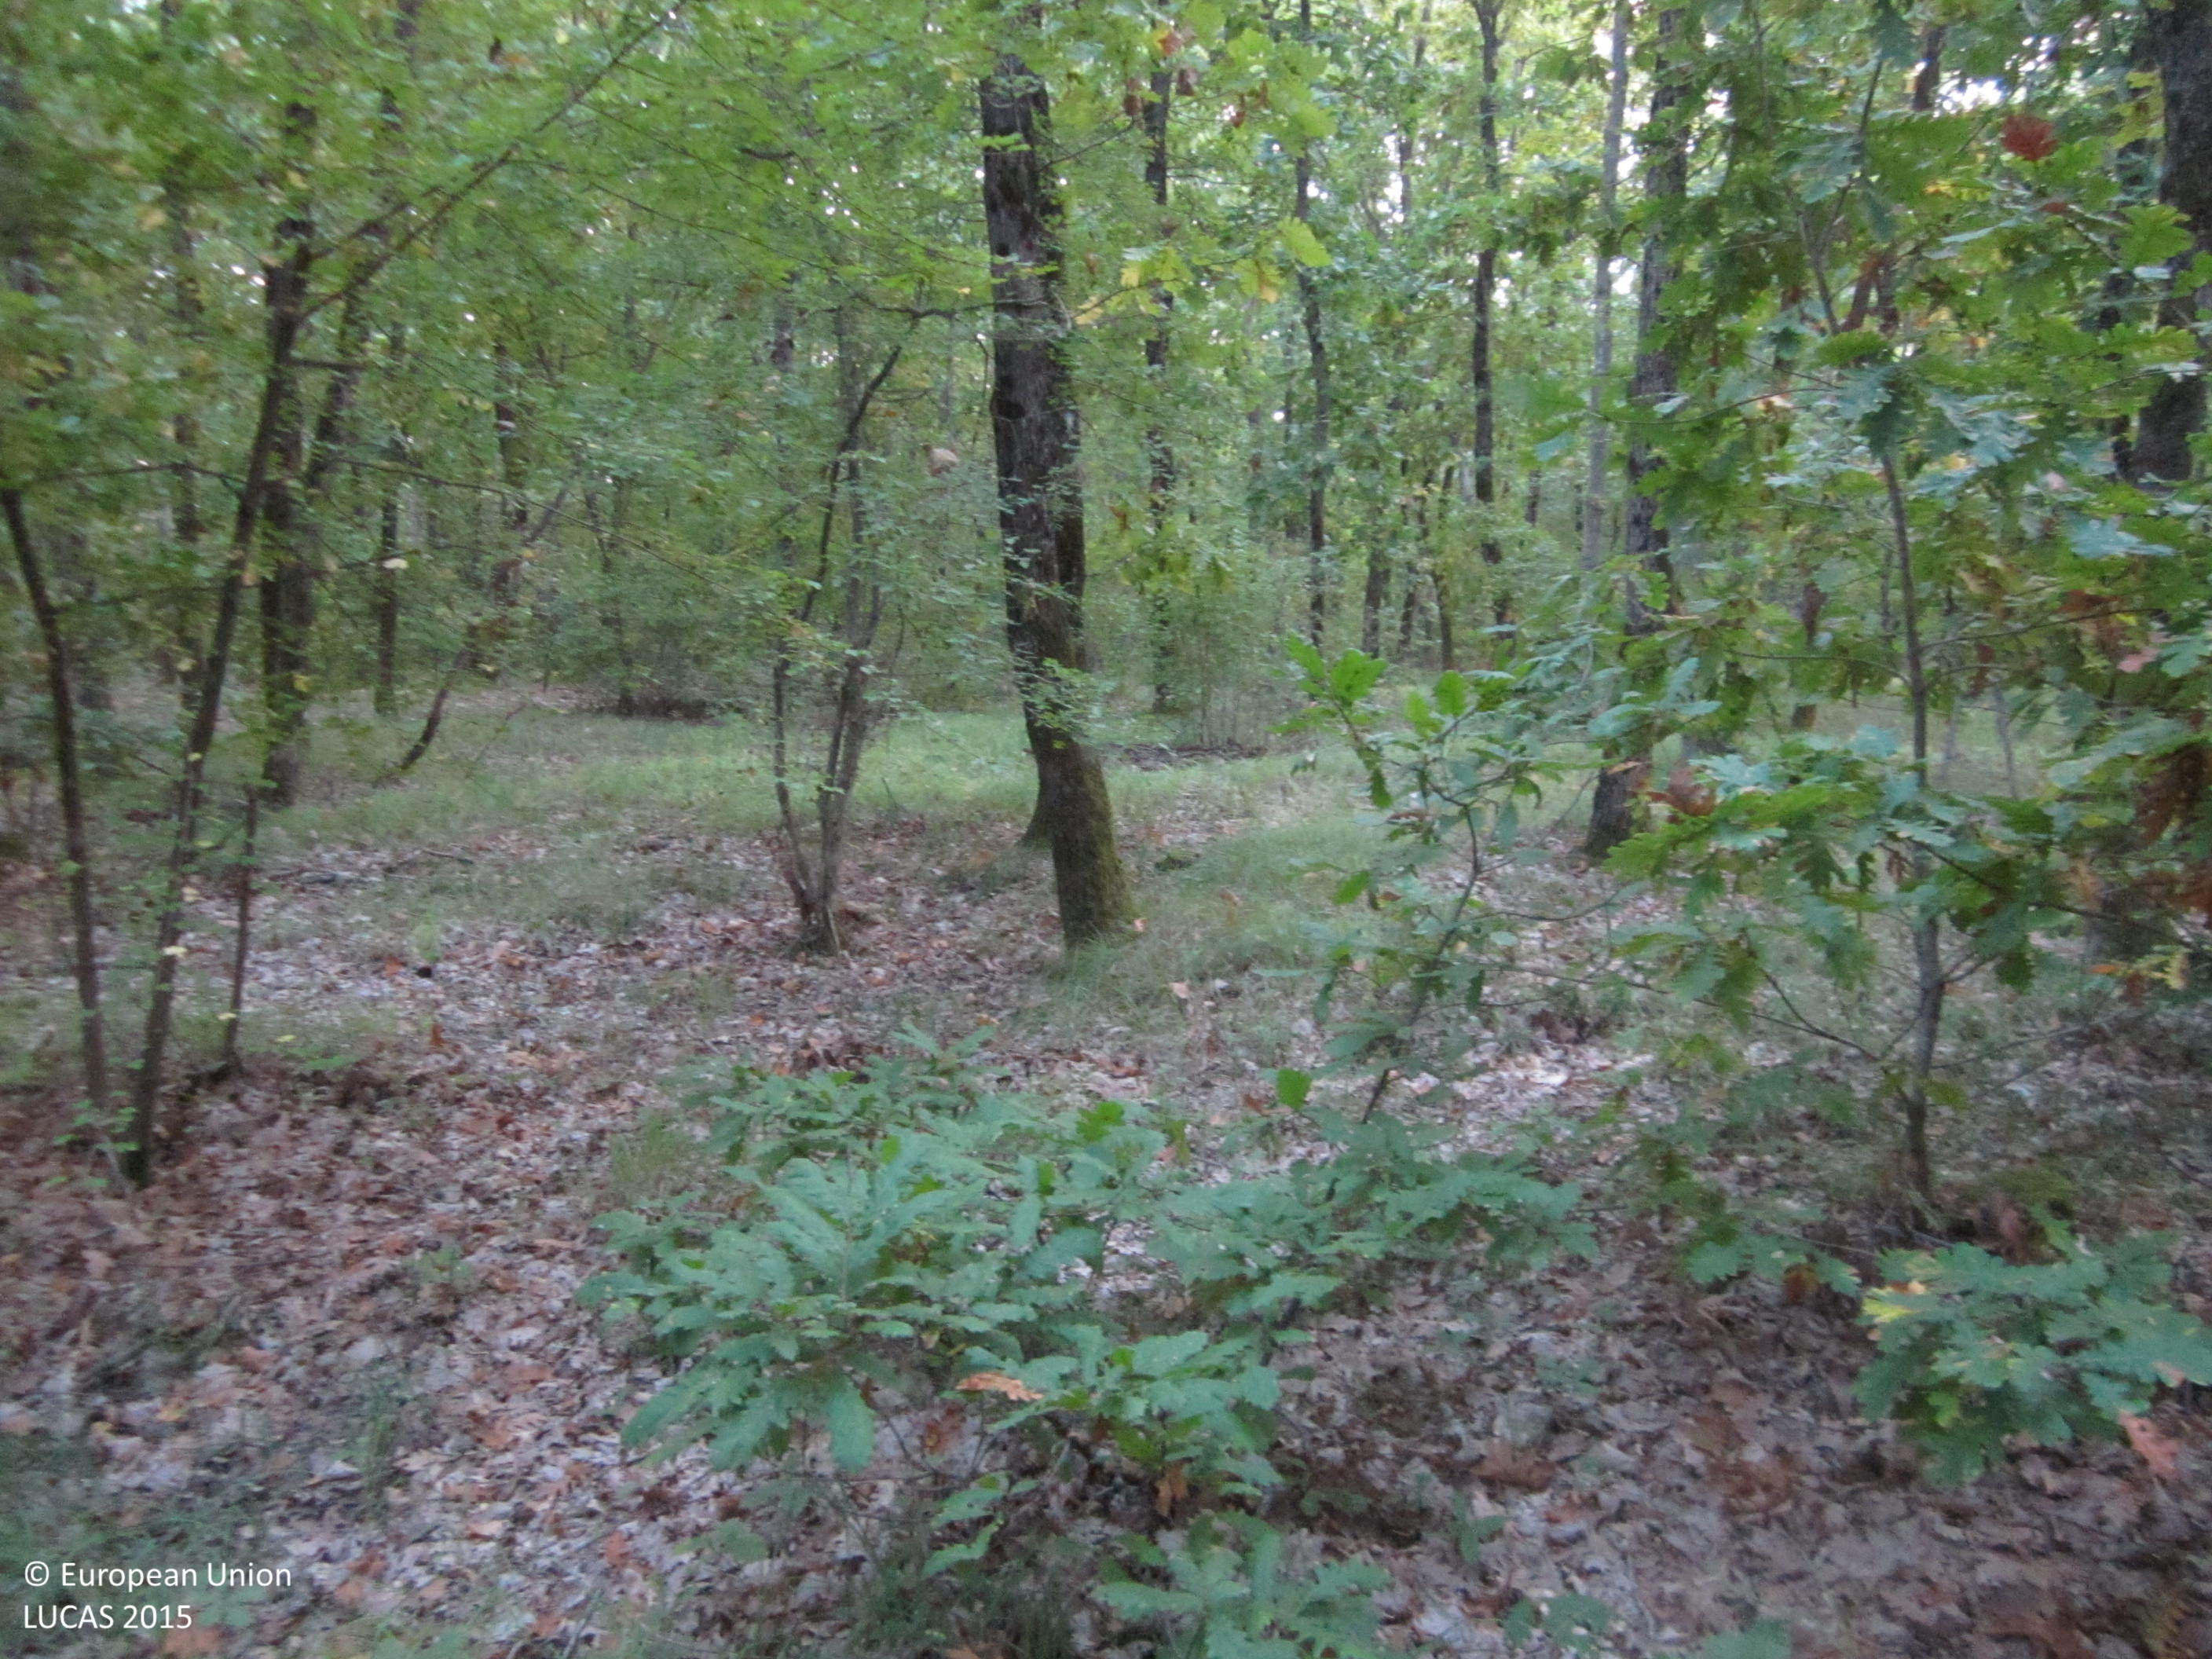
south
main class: Woodland
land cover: Broadleaved woodland
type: thermophilous deciduous forest
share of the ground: > 75 %
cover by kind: broadleaved forest trees 90 %, herbaceous plants 5 %, unconsolidated bare surface 5 %
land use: Forestry
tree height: > 5 m
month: September
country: BG
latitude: 42.2332
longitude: 27.7514
